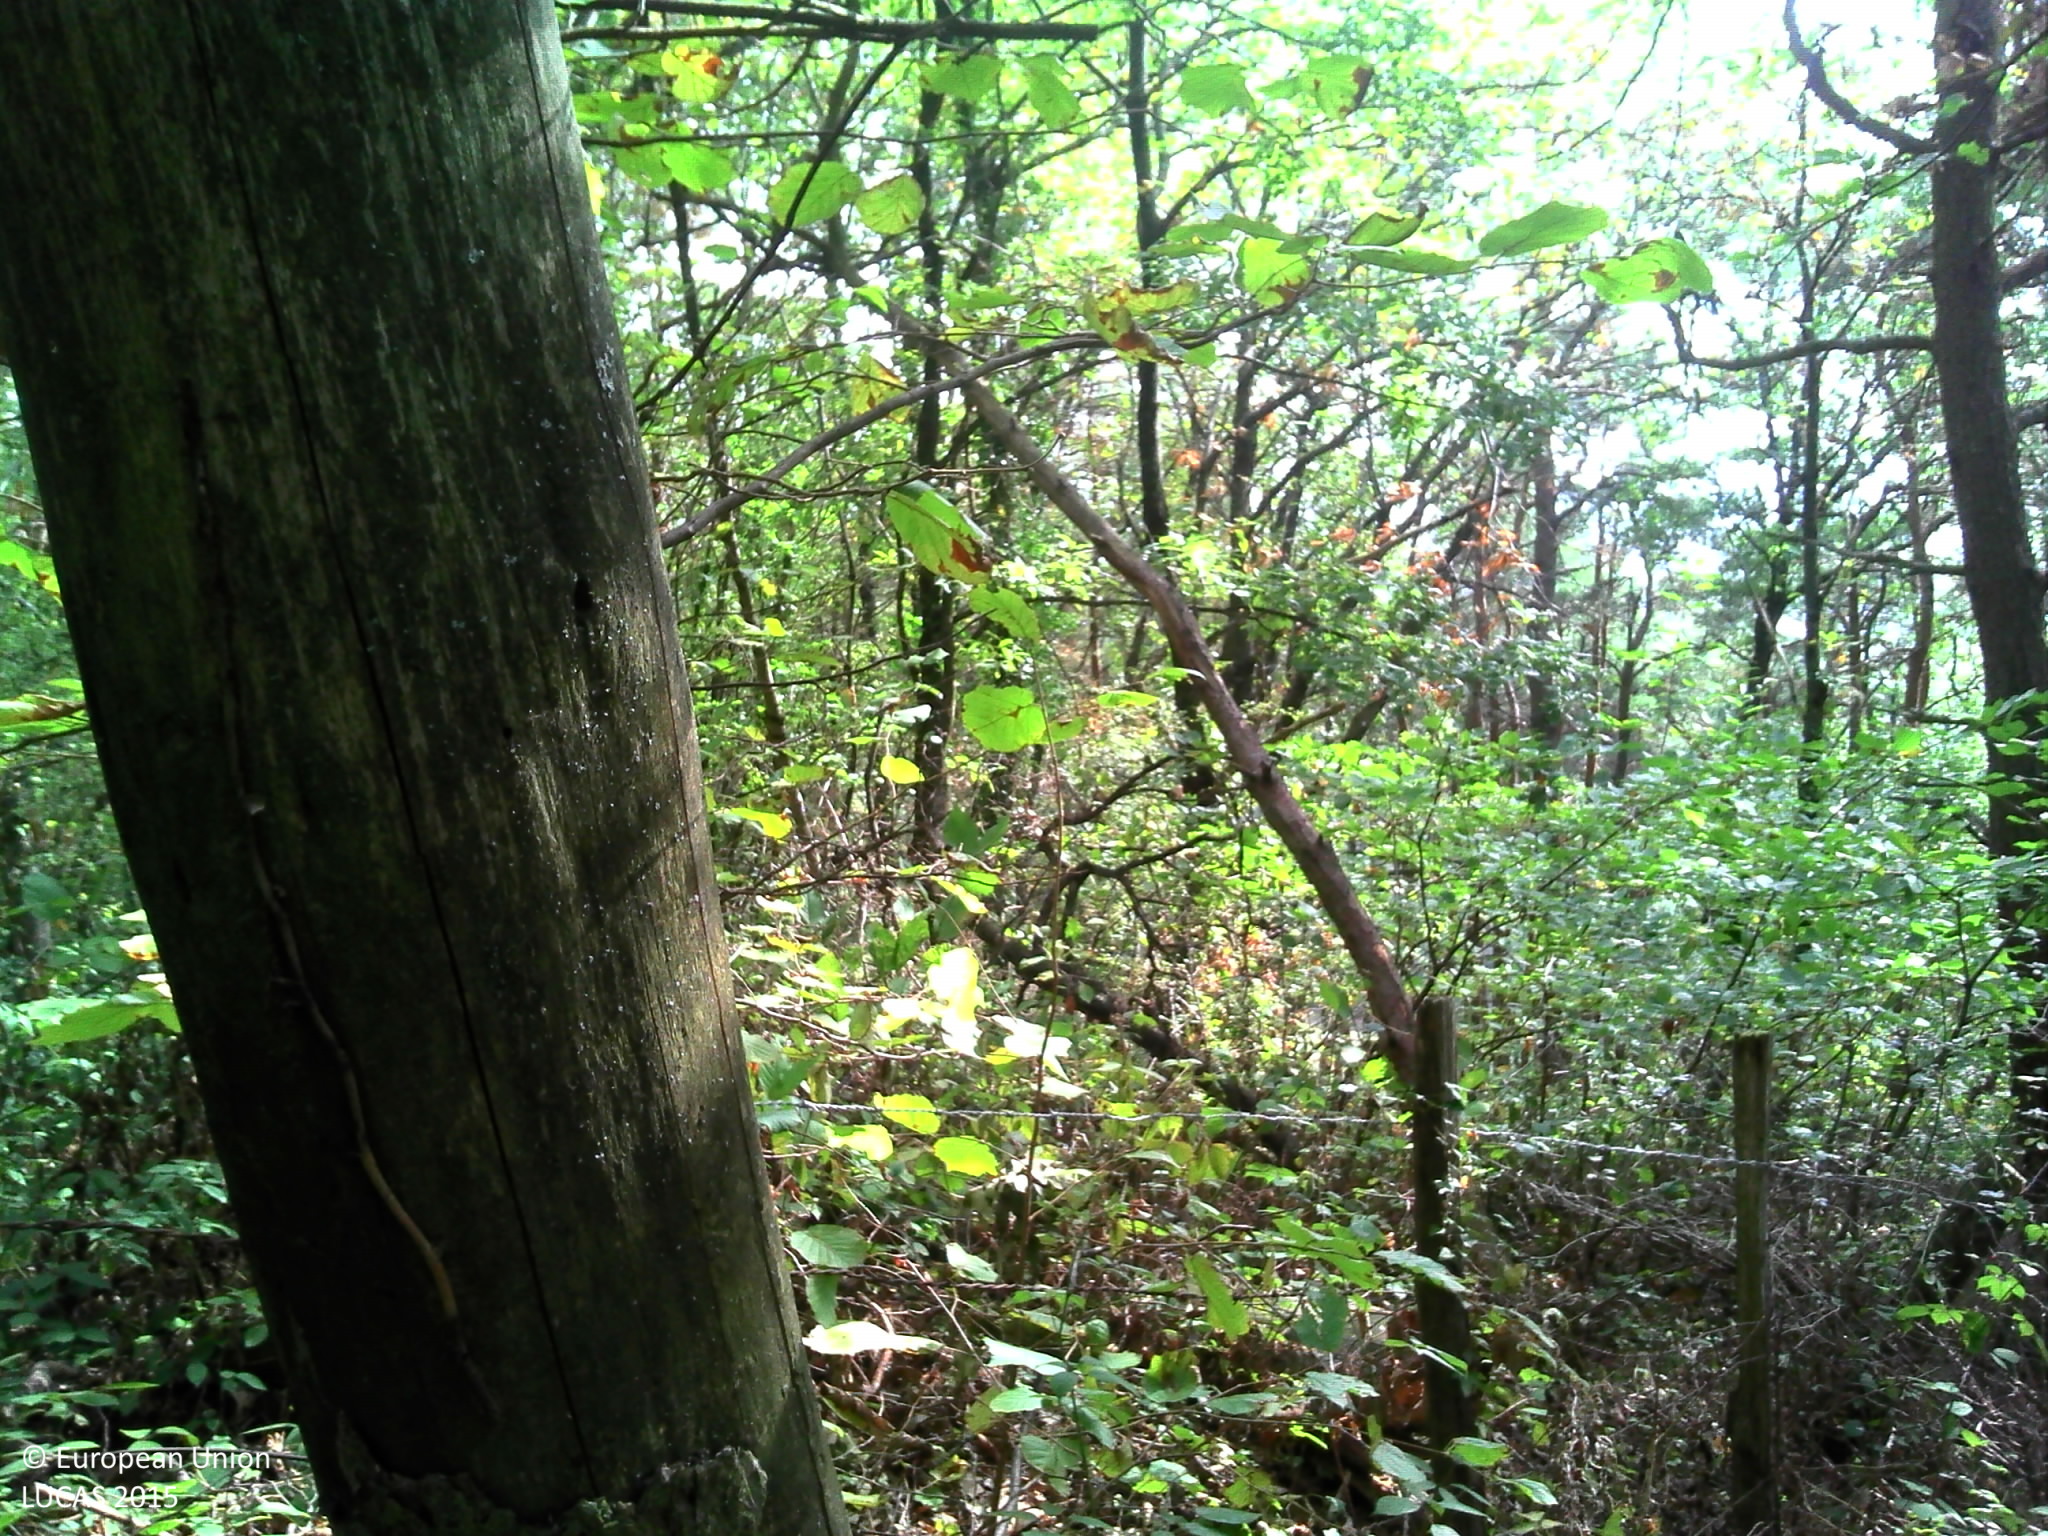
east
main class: Woodland
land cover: Broadleaved woodland
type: mesophytic deciduous forest
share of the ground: > 75 %
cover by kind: broadleaved forest trees 90 %, herbaceous plants 5 %, lichens and mosses 5 %
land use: Forestry
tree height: > 5 m
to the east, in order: Broadleaved woodland; Fences; Broadleaved woodland; Pine dominated coniferous woodland; Grassland without tree/shrub cover; Fences; Other fresh vegetables; Grass margins; Tracks; Broadleaved woodland; Other fresh vegetables
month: October
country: FR
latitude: 45.6385
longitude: 4.6282
